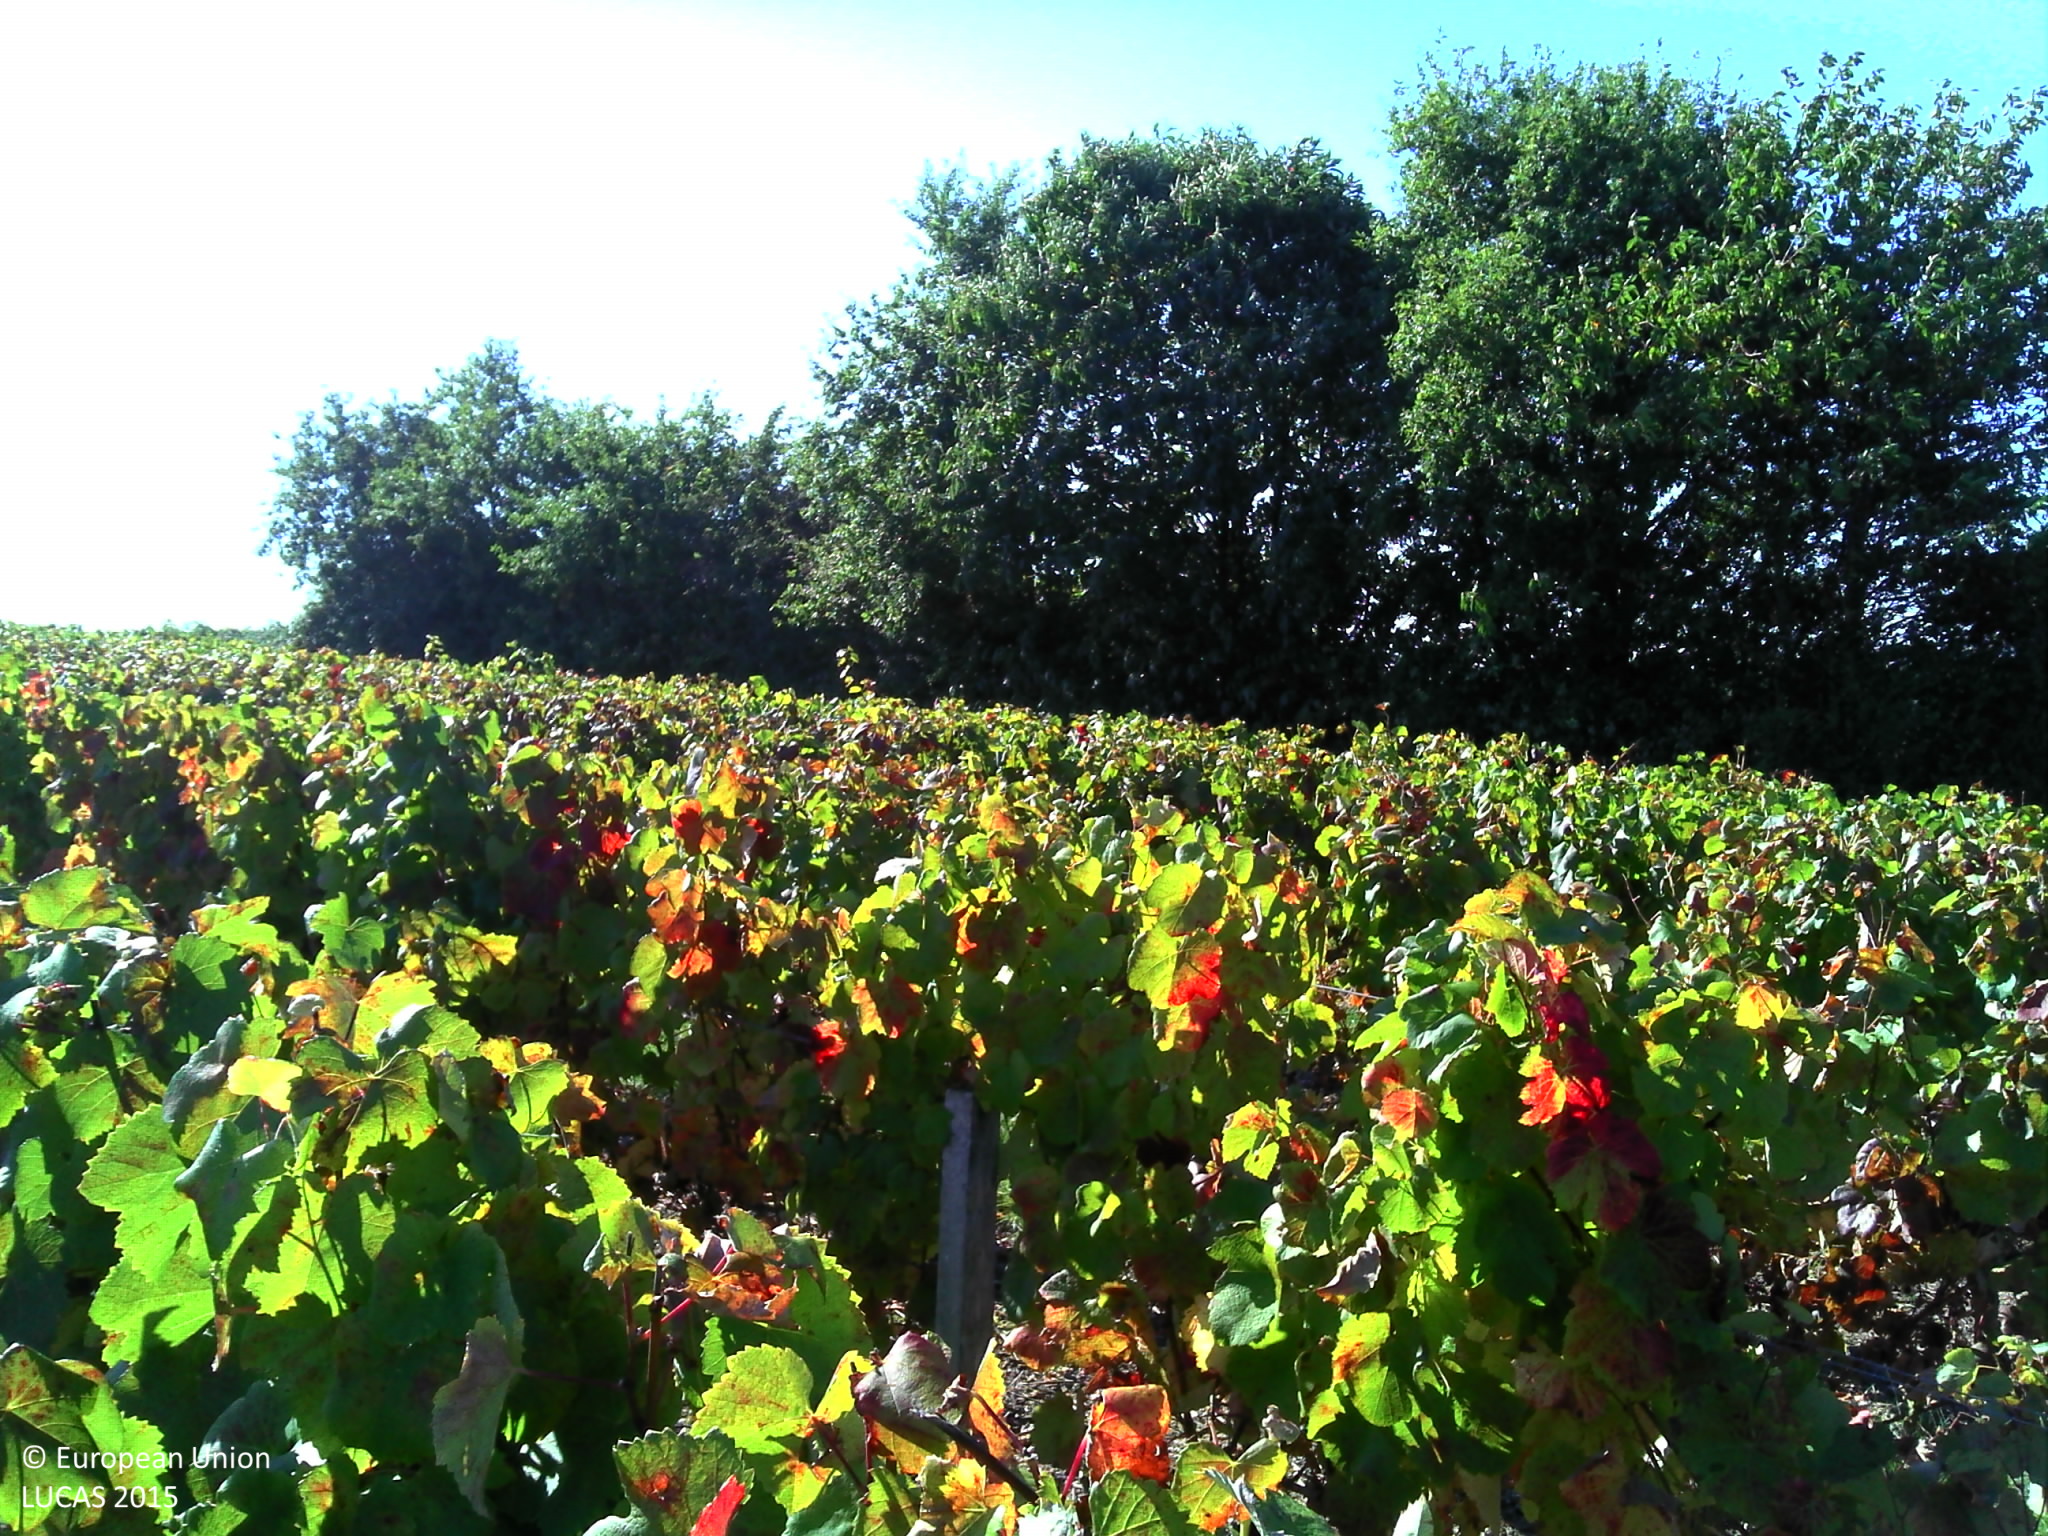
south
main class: Cropland
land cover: Vineyards
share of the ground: > 75 %
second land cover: Other bare soil
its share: > 75 %
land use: Agriculture (excluding fallow land and kitchen gardens)
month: September
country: FR
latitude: 46.5306
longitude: -1.3132
